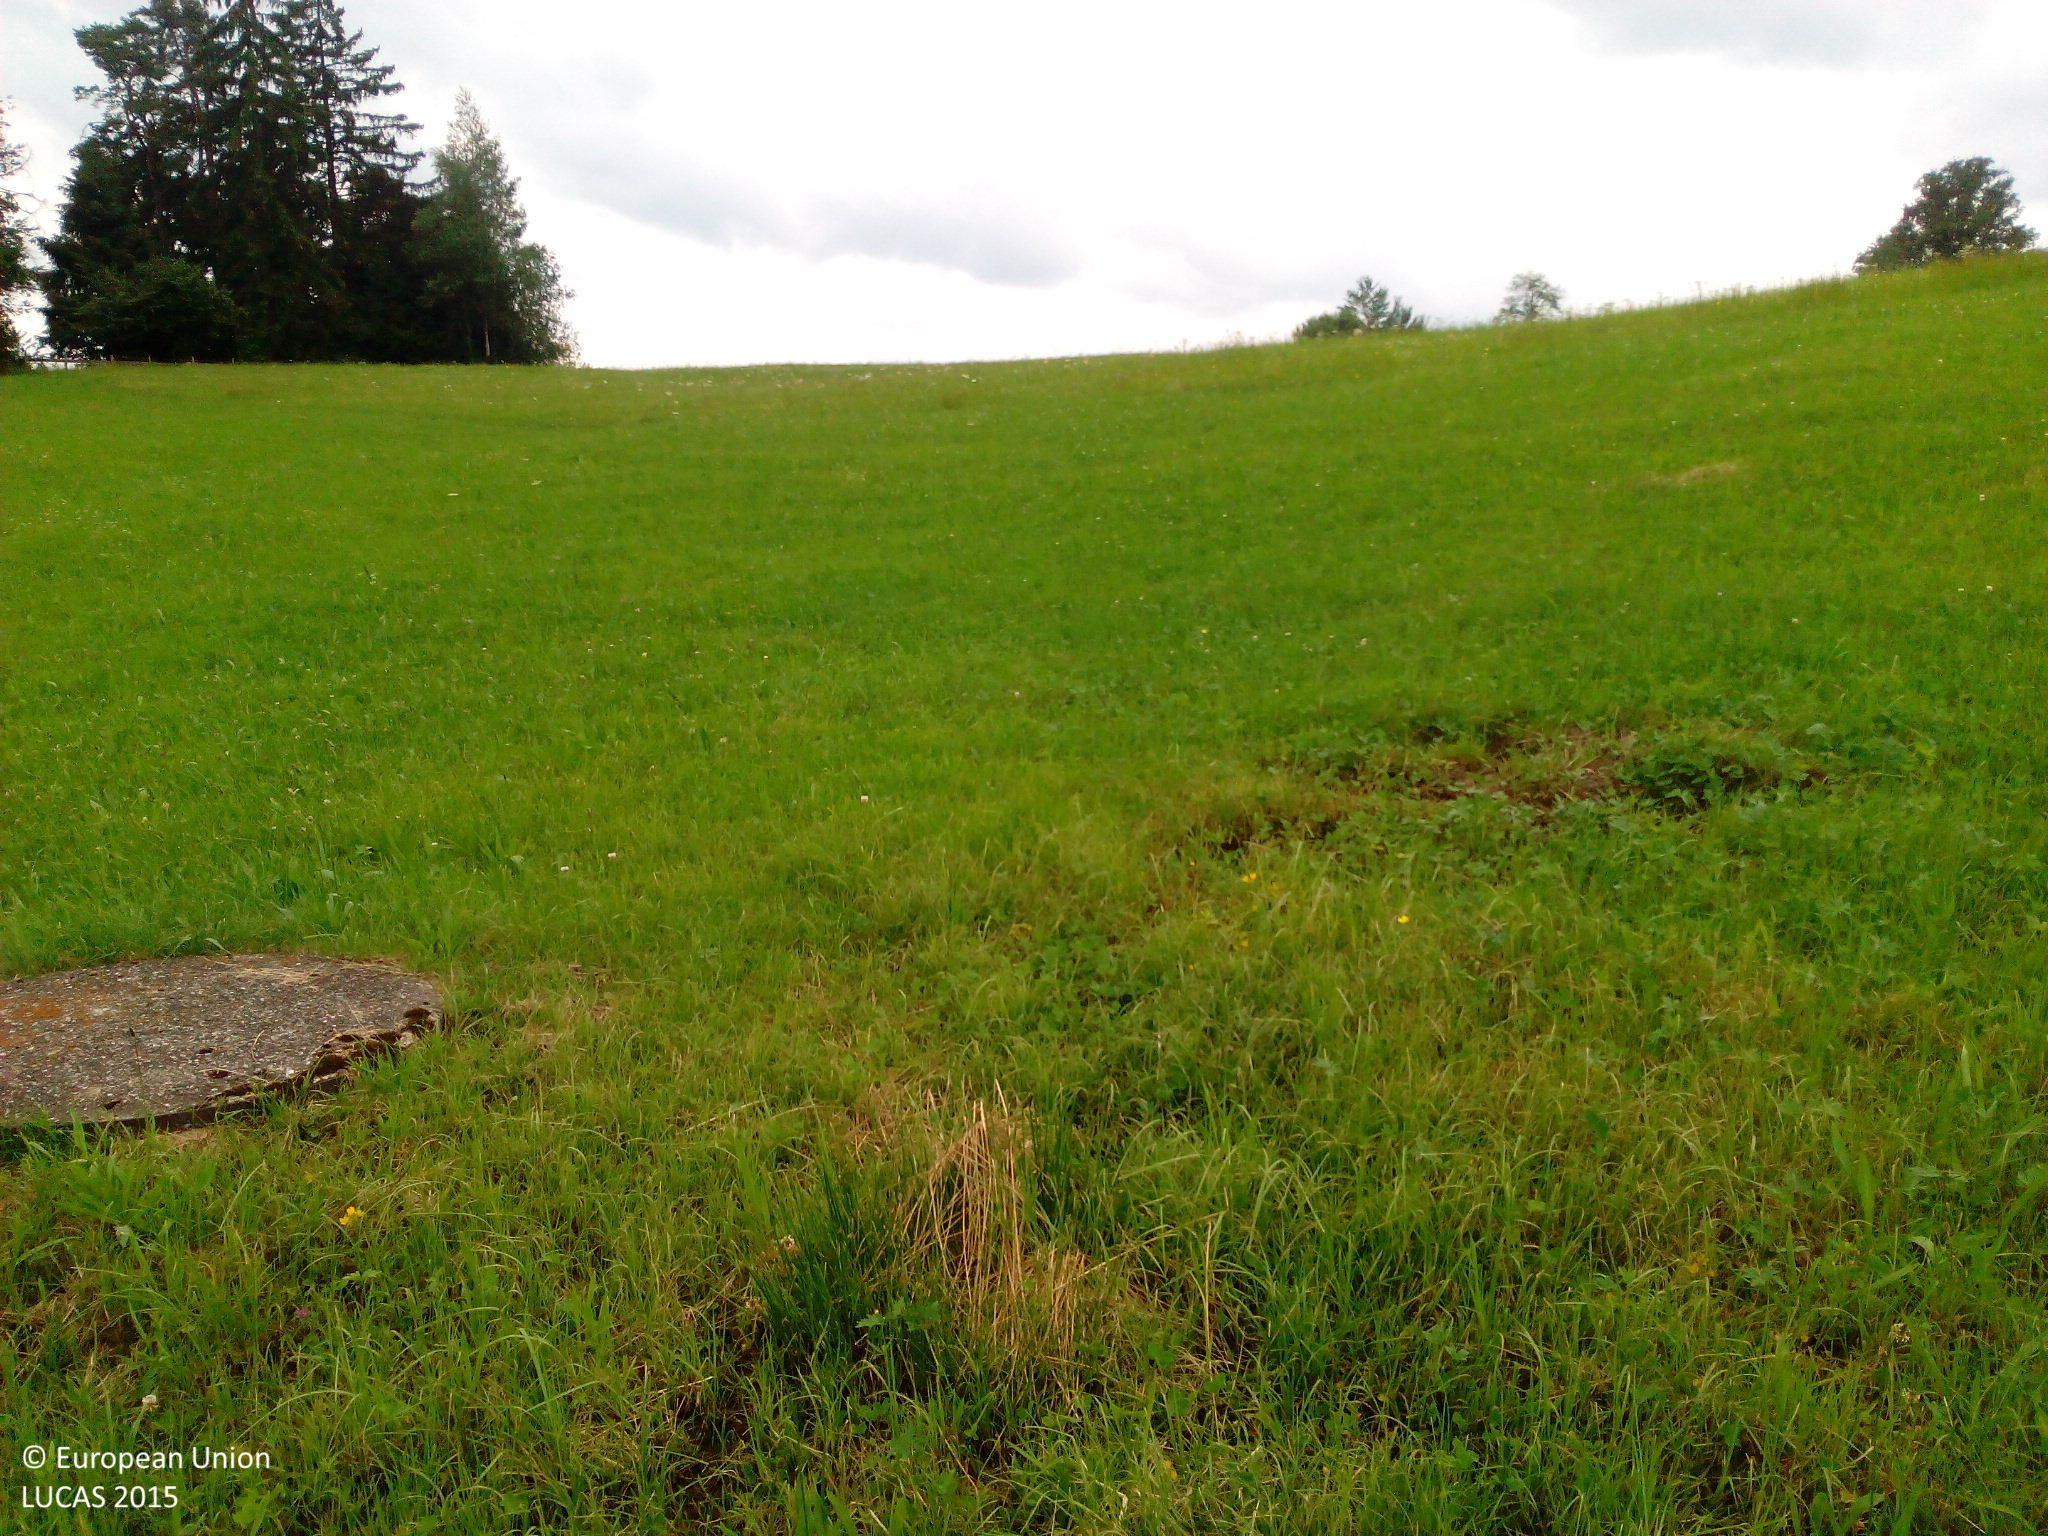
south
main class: Grassland
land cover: Grassland without tree/shrub cover
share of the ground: > 75 %
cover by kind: herbaceous plants 100 %
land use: Agriculture (excluding fallow land and kitchen gardens)
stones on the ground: < 10 %
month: June
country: DE
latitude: 47.6473
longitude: 10.2527
